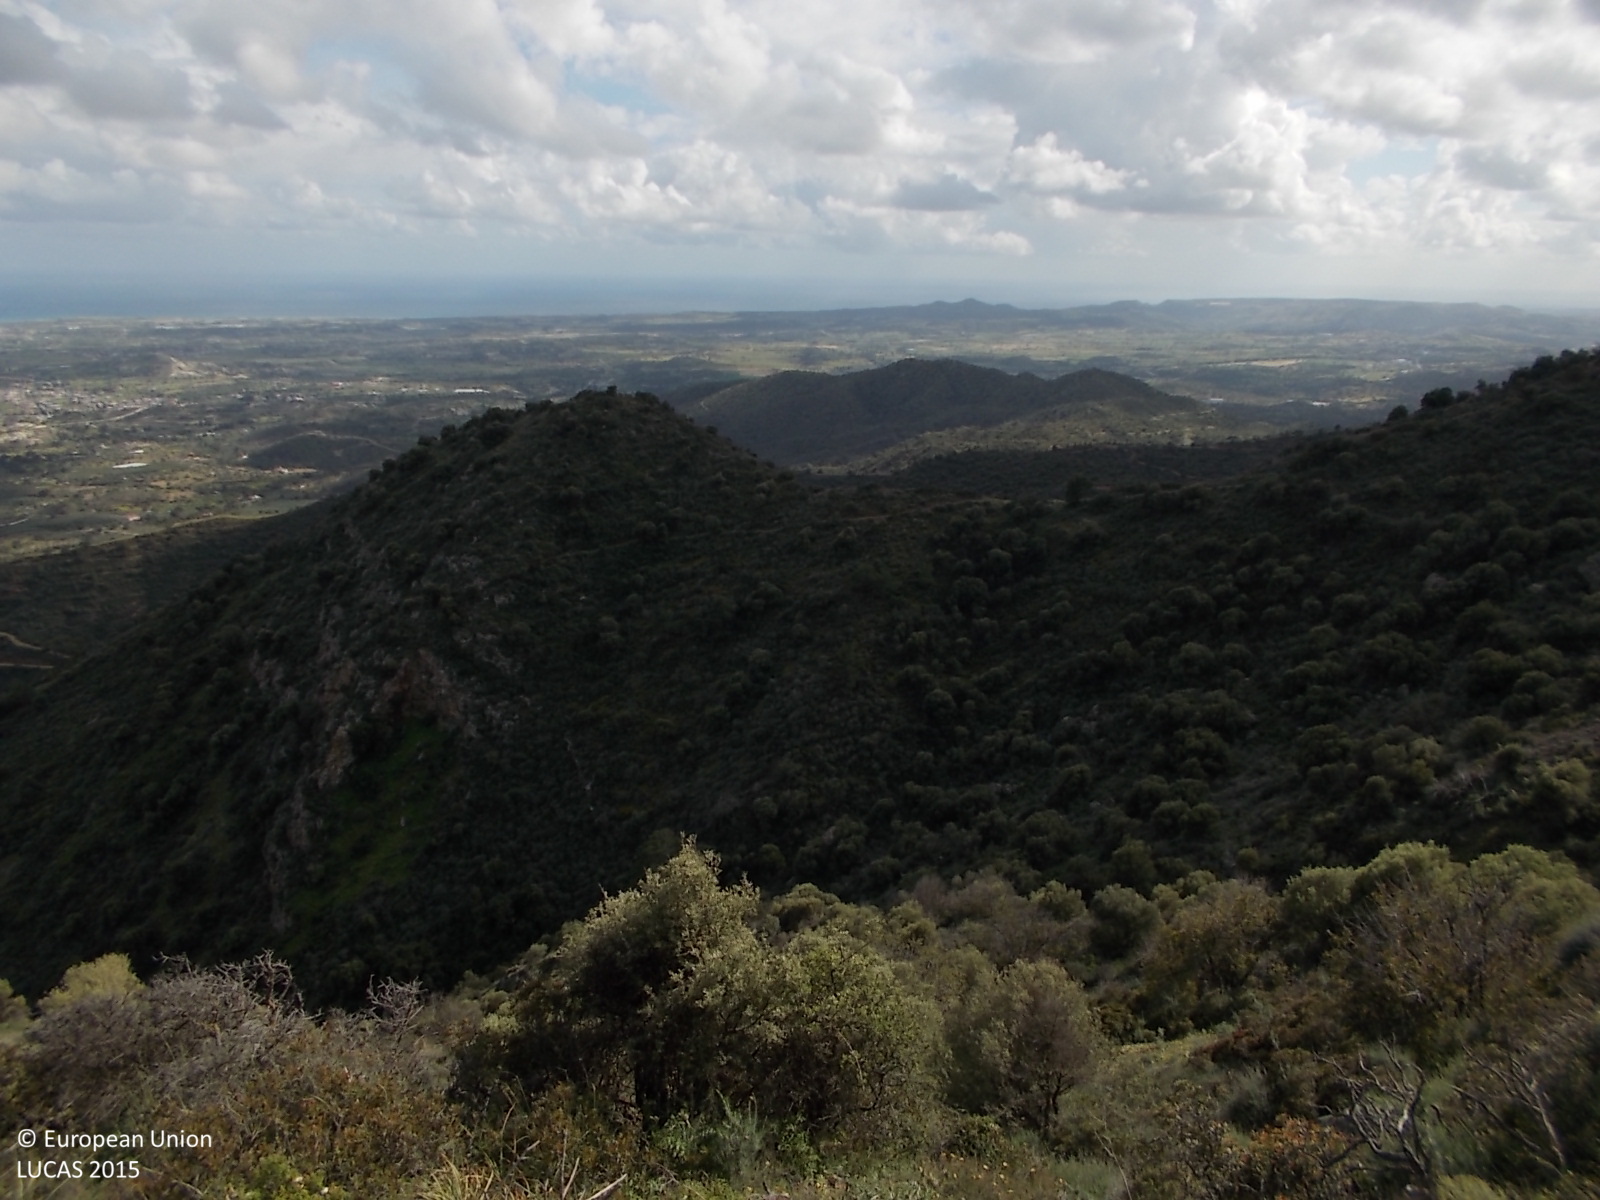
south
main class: Shrubland
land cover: Shrubland without tree cover
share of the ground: > 75 %
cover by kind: shrubs 85 %, unconsolidated bare surface 15 %
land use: Semi-natural and natural areas not in use
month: April
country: CY
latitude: 34.8871
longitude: 33.4388
